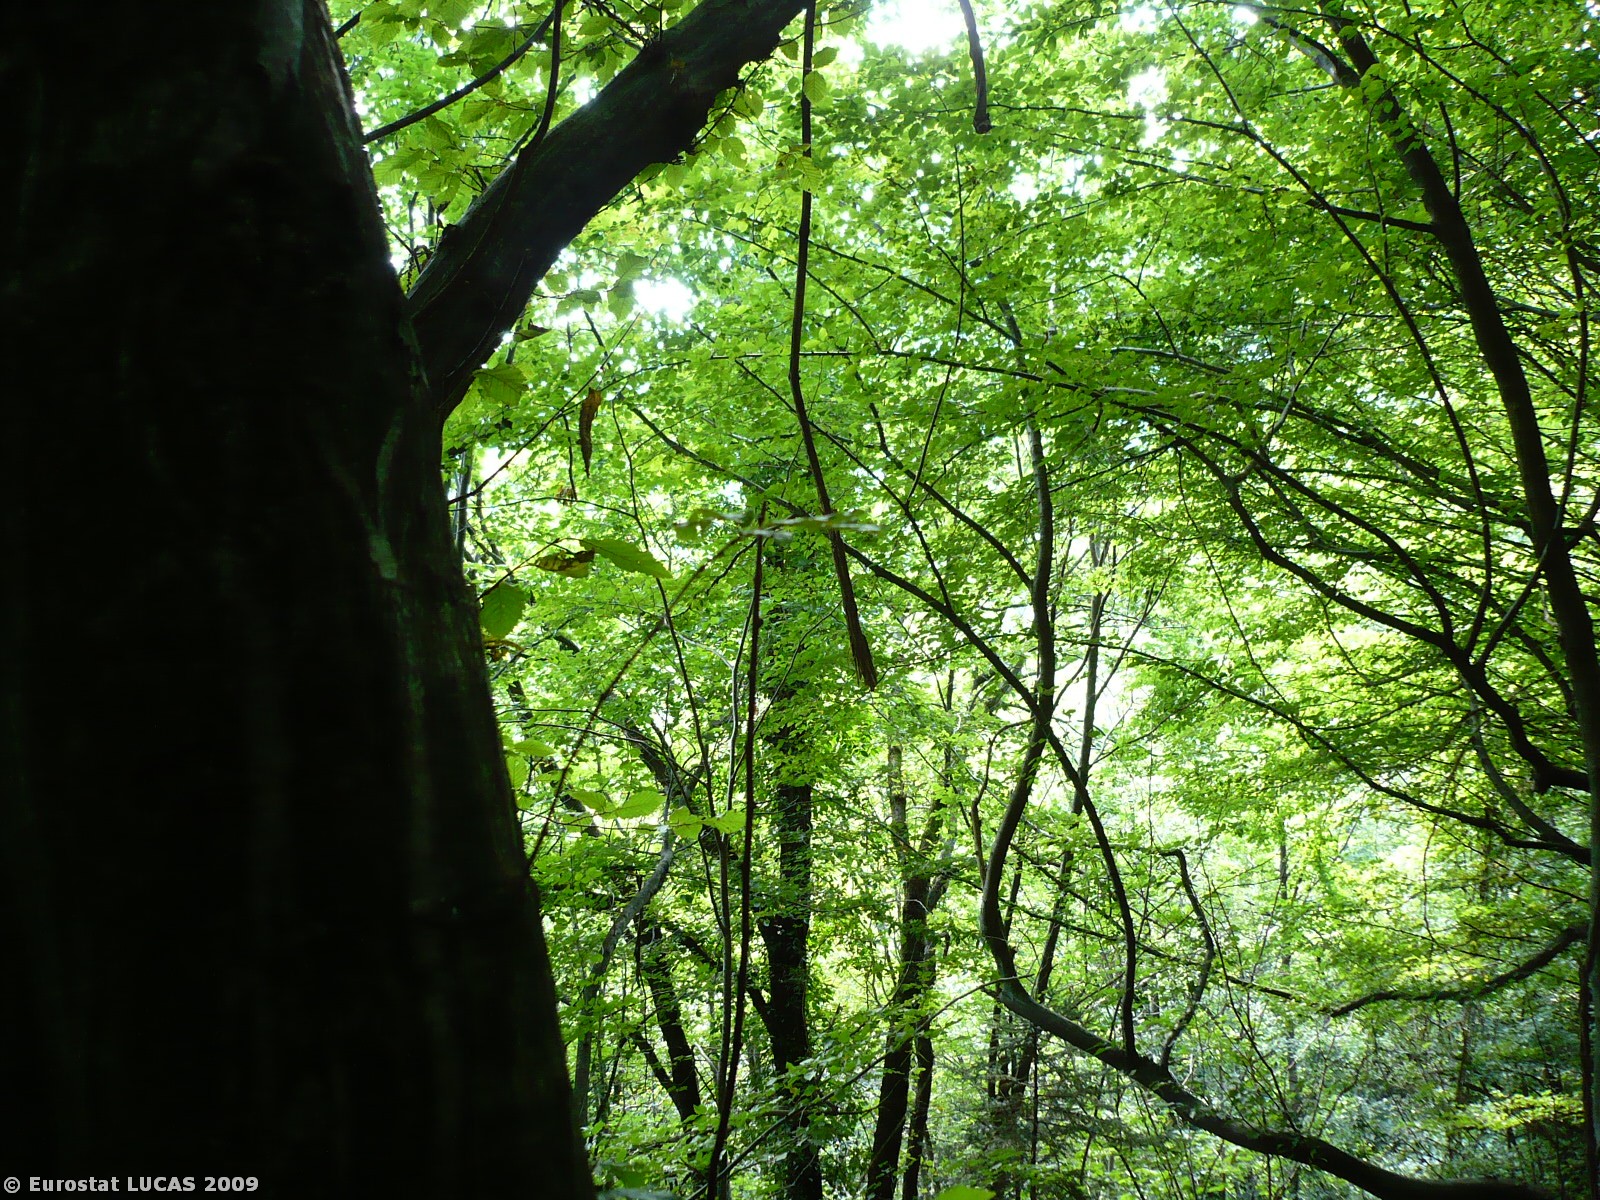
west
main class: Woodland
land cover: Broadleaved woodland
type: mesophytic deciduous forest
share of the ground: > 75 %
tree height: > 5 m
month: August
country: SI
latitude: 46.1615
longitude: 13.6873
